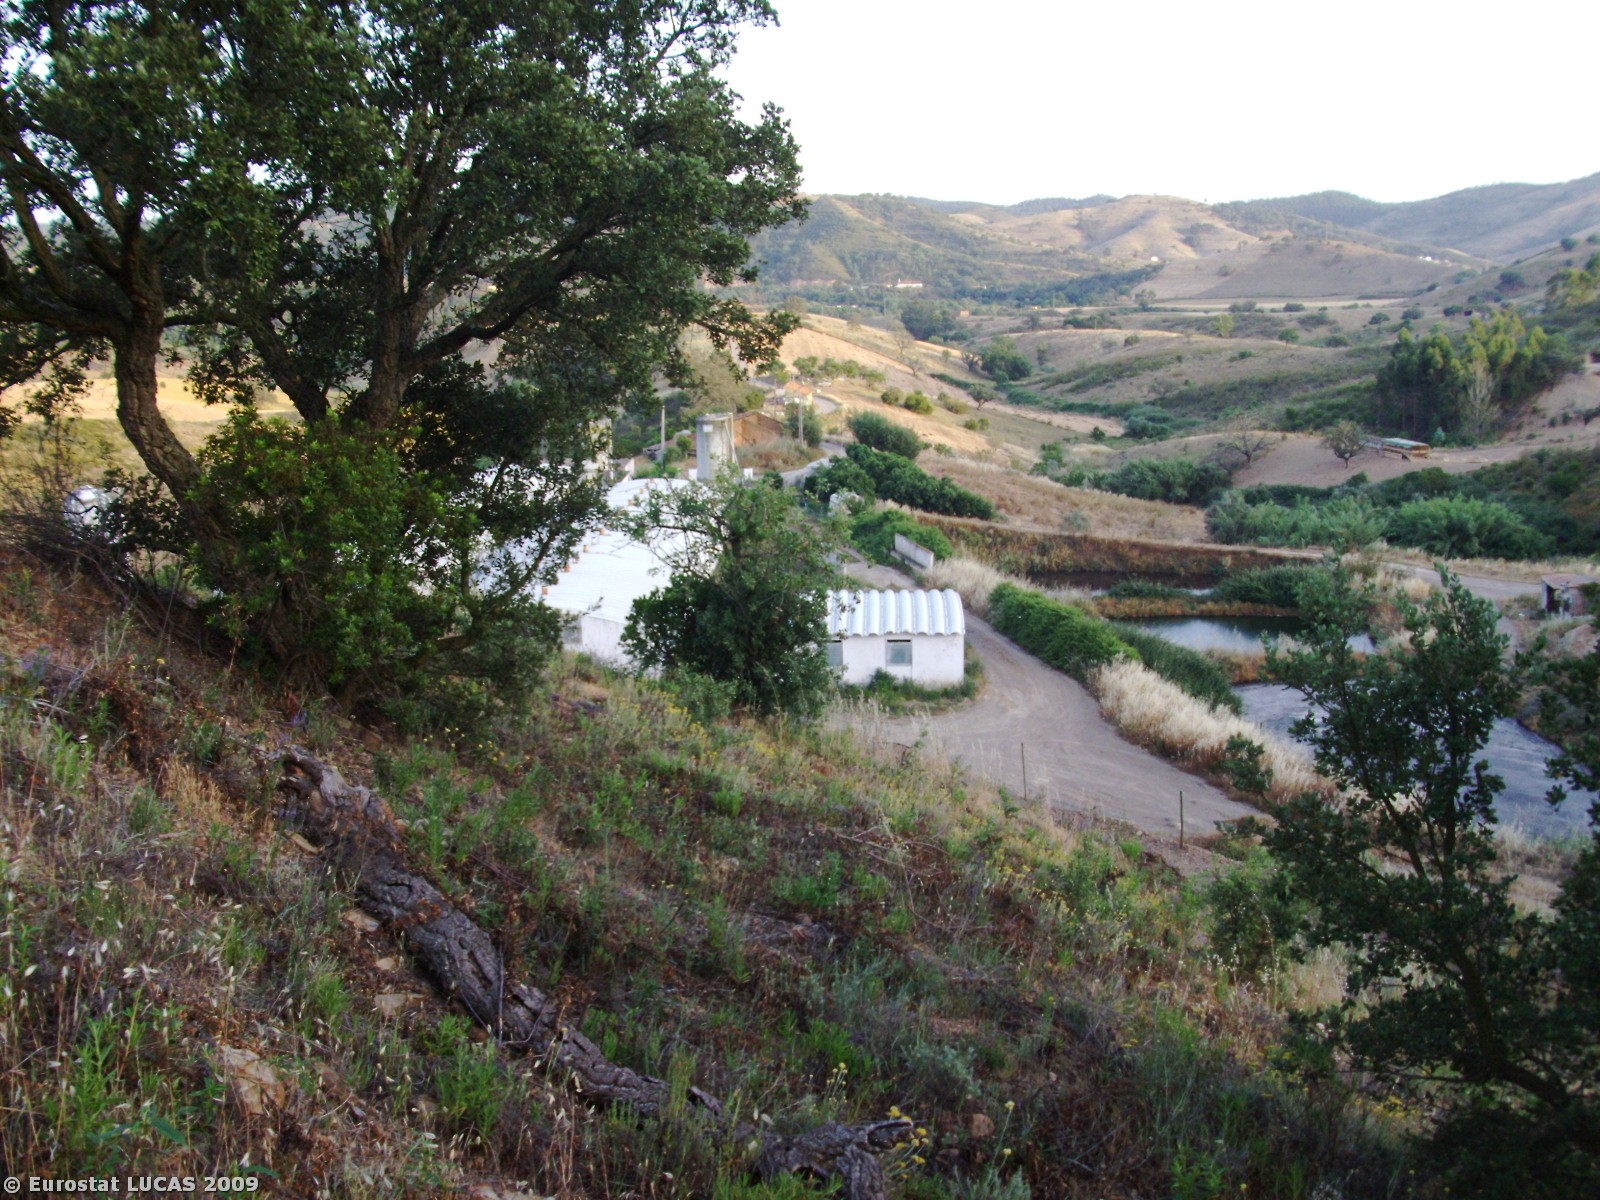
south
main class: Woodland
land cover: Broadleaved woodland
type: broadleaved evergreen forest
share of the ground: 10 - 25 %
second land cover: Spontaneously vegetated surfaces
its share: 50 - 75 %
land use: Forestry
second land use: Fallow land
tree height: > 5 m
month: May
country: PT
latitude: 37.3976
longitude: -8.3141
